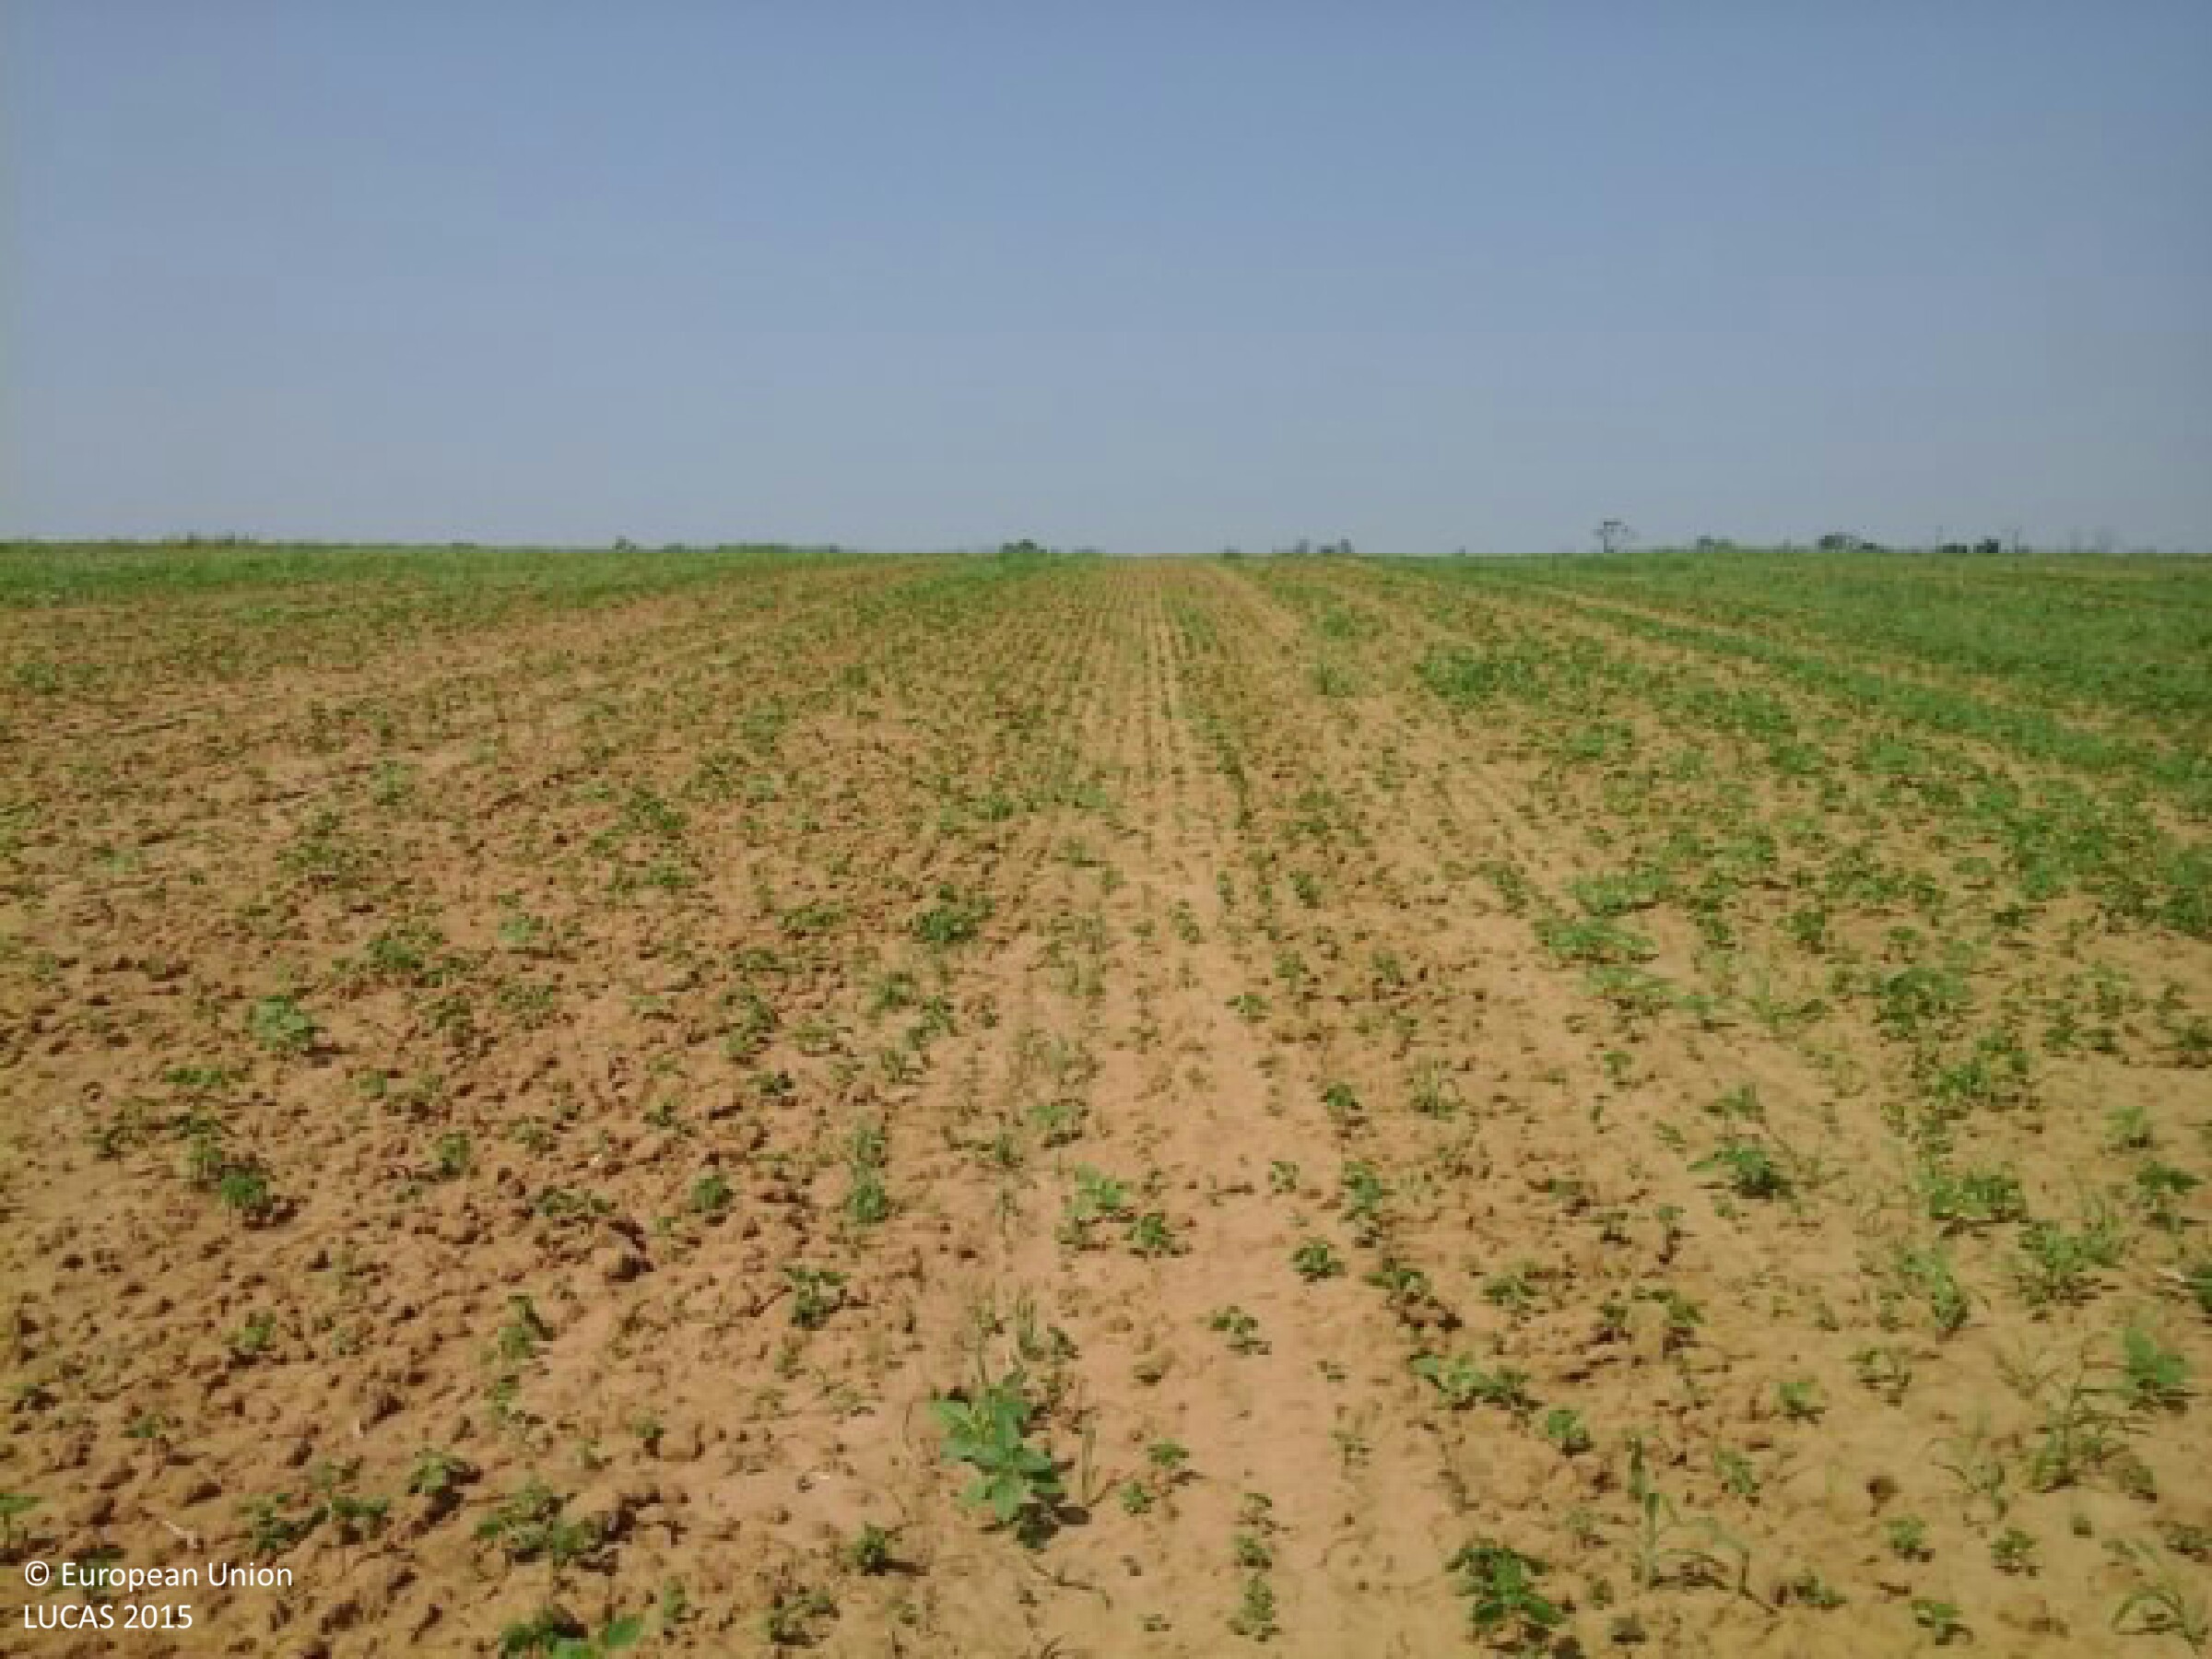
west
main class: Cropland
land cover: Other cereals
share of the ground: 50 - 75 %
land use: Agriculture (excluding fallow land and kitchen gardens)
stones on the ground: < 10 %
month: August
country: HU
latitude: 46.5314
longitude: 17.8686
